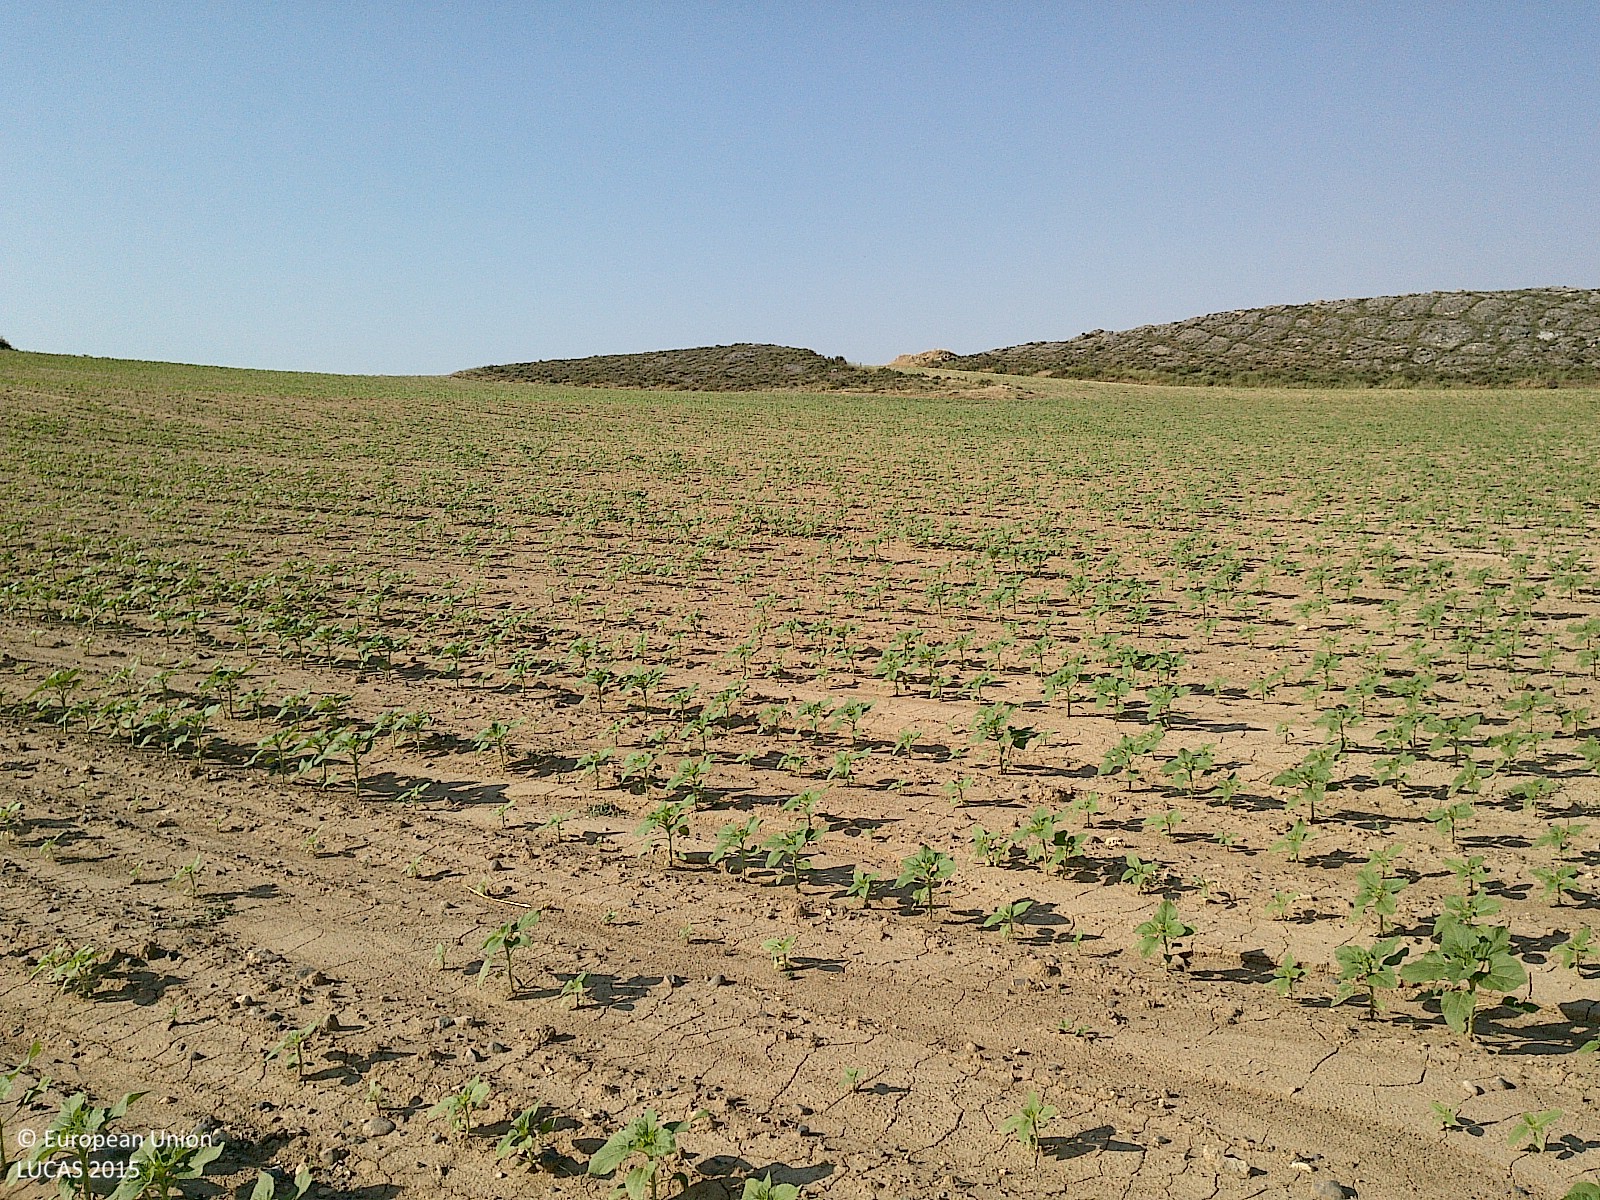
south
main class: Cropland
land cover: Sunflower
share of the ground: < 10 %
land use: Agriculture (excluding fallow land and kitchen gardens)
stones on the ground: < 10 %
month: June
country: ES
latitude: 41.6346
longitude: -2.2426
